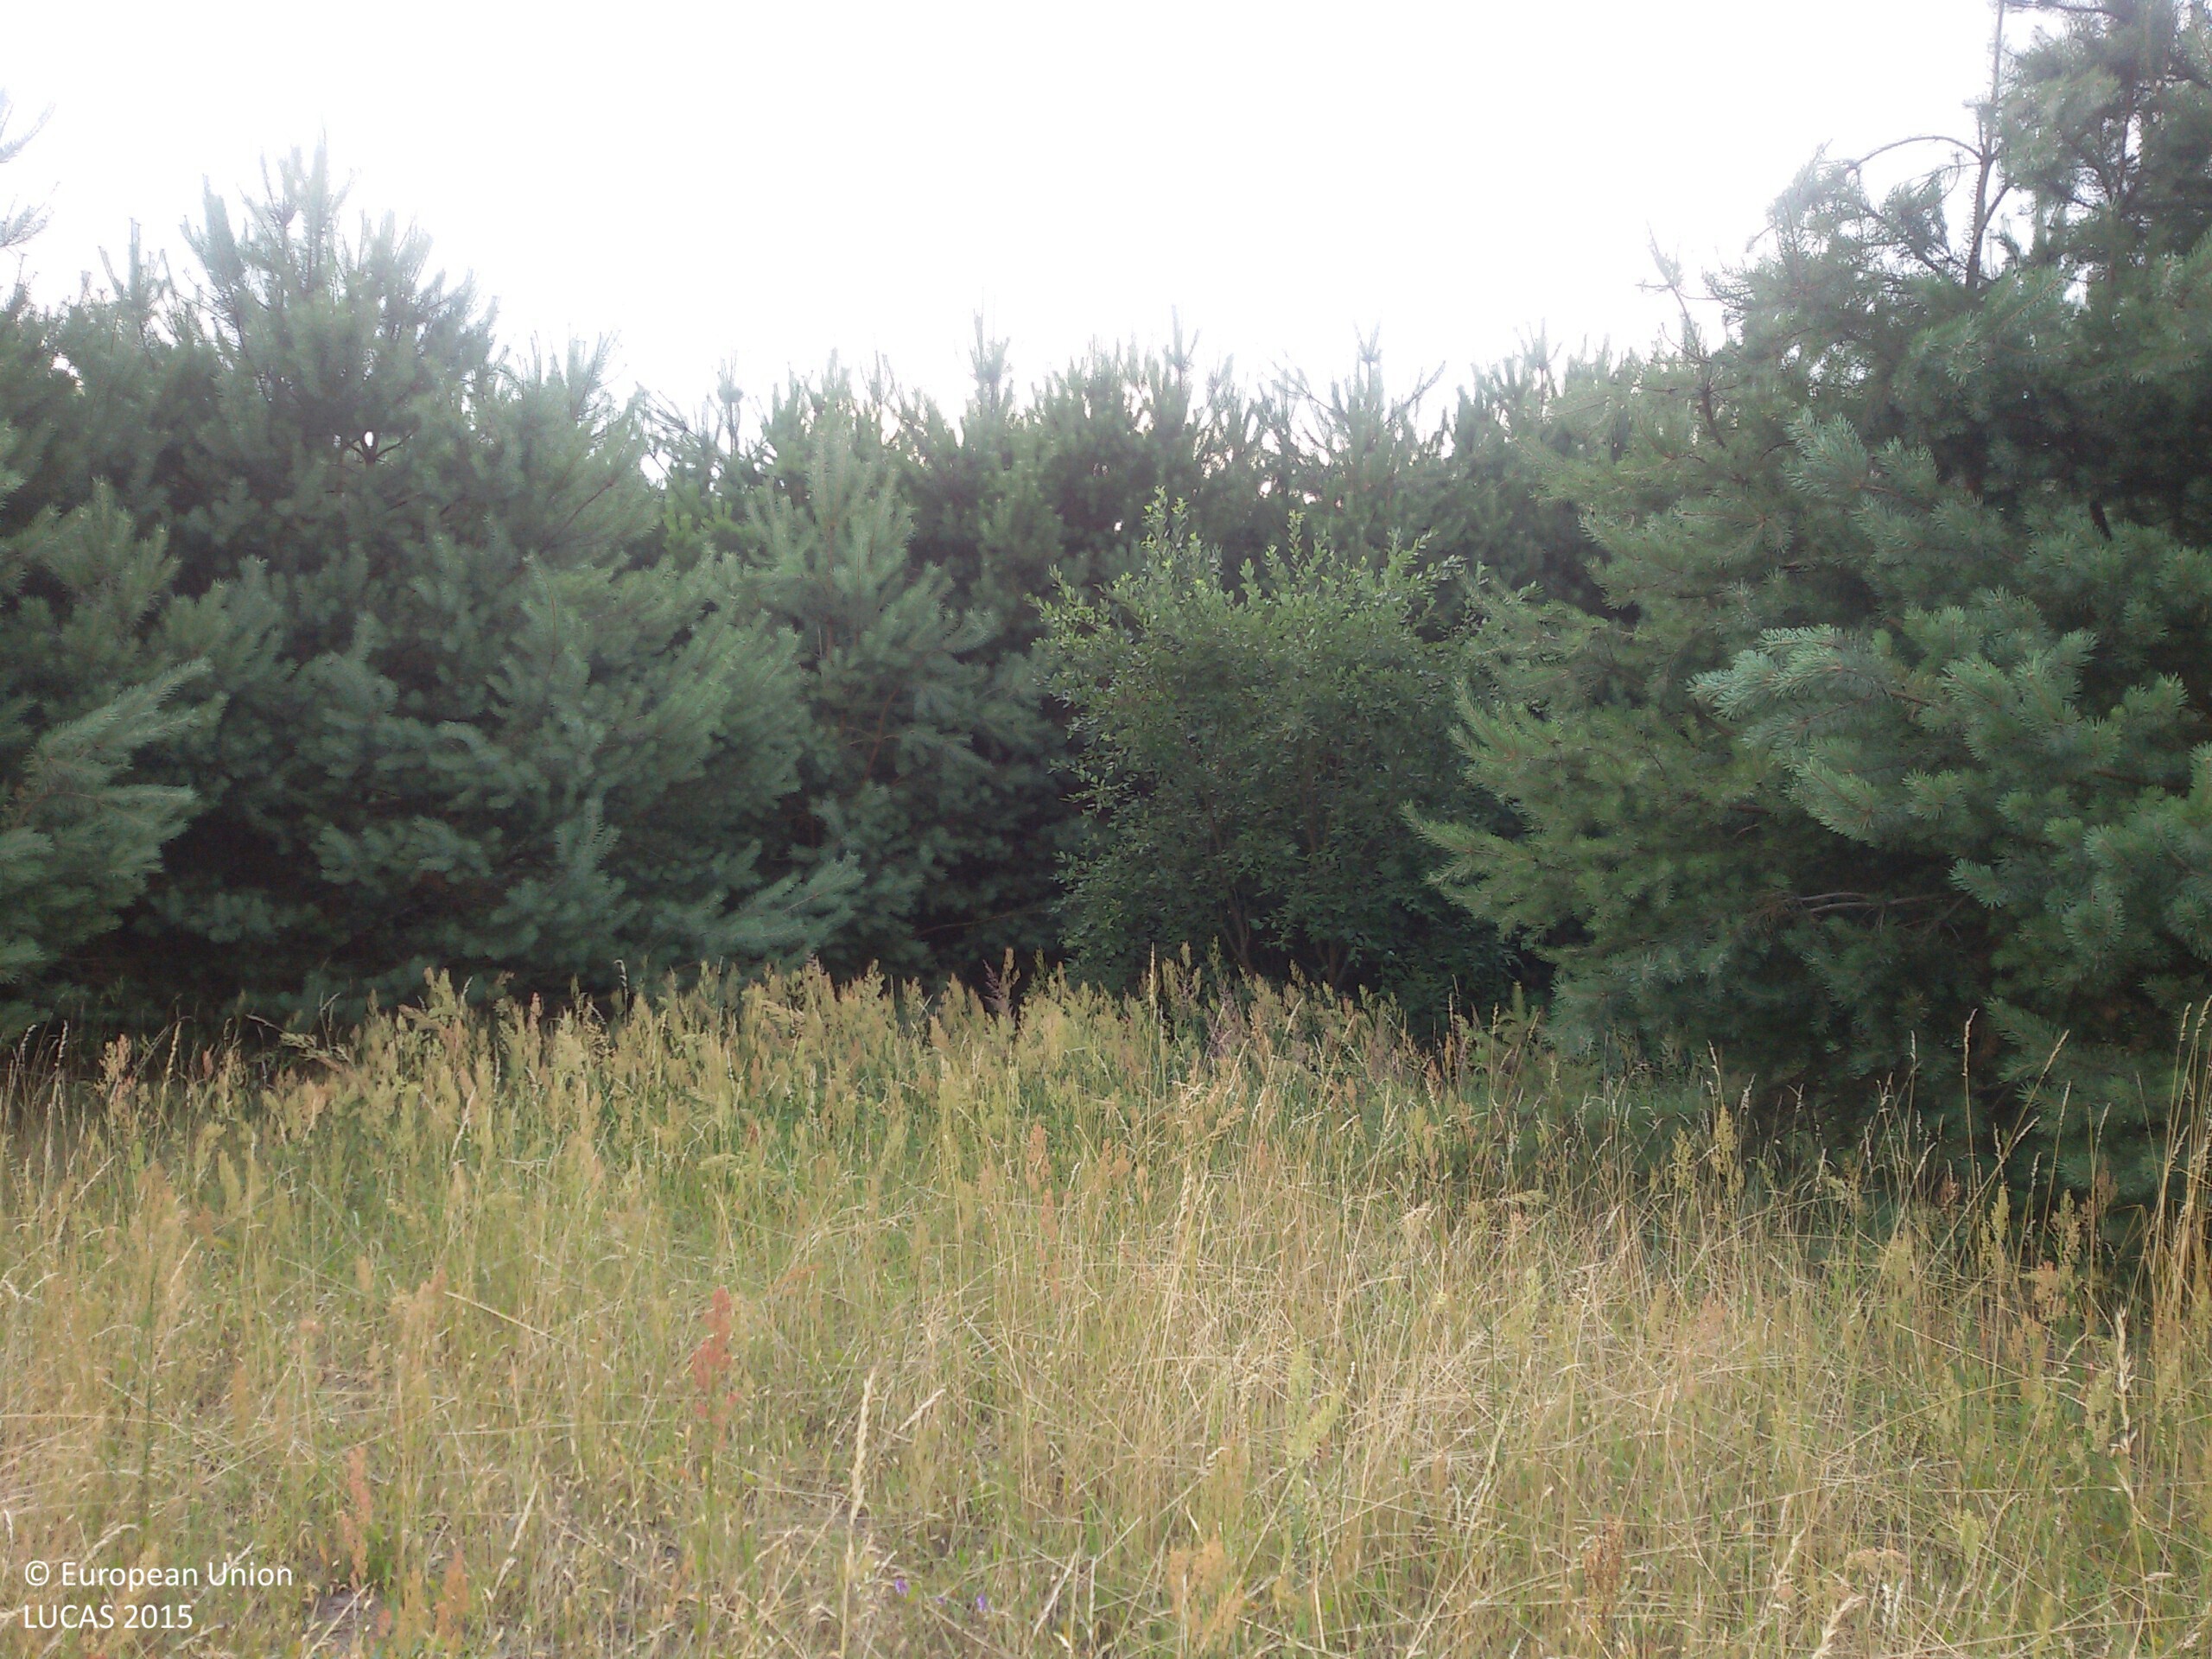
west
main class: Grassland
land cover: Grassland without tree/shrub cover
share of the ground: > 75 %
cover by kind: herbaceous plants 100 %
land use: Semi-natural and natural areas not in use
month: July
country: PL
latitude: 50.3596
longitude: 20.7947
